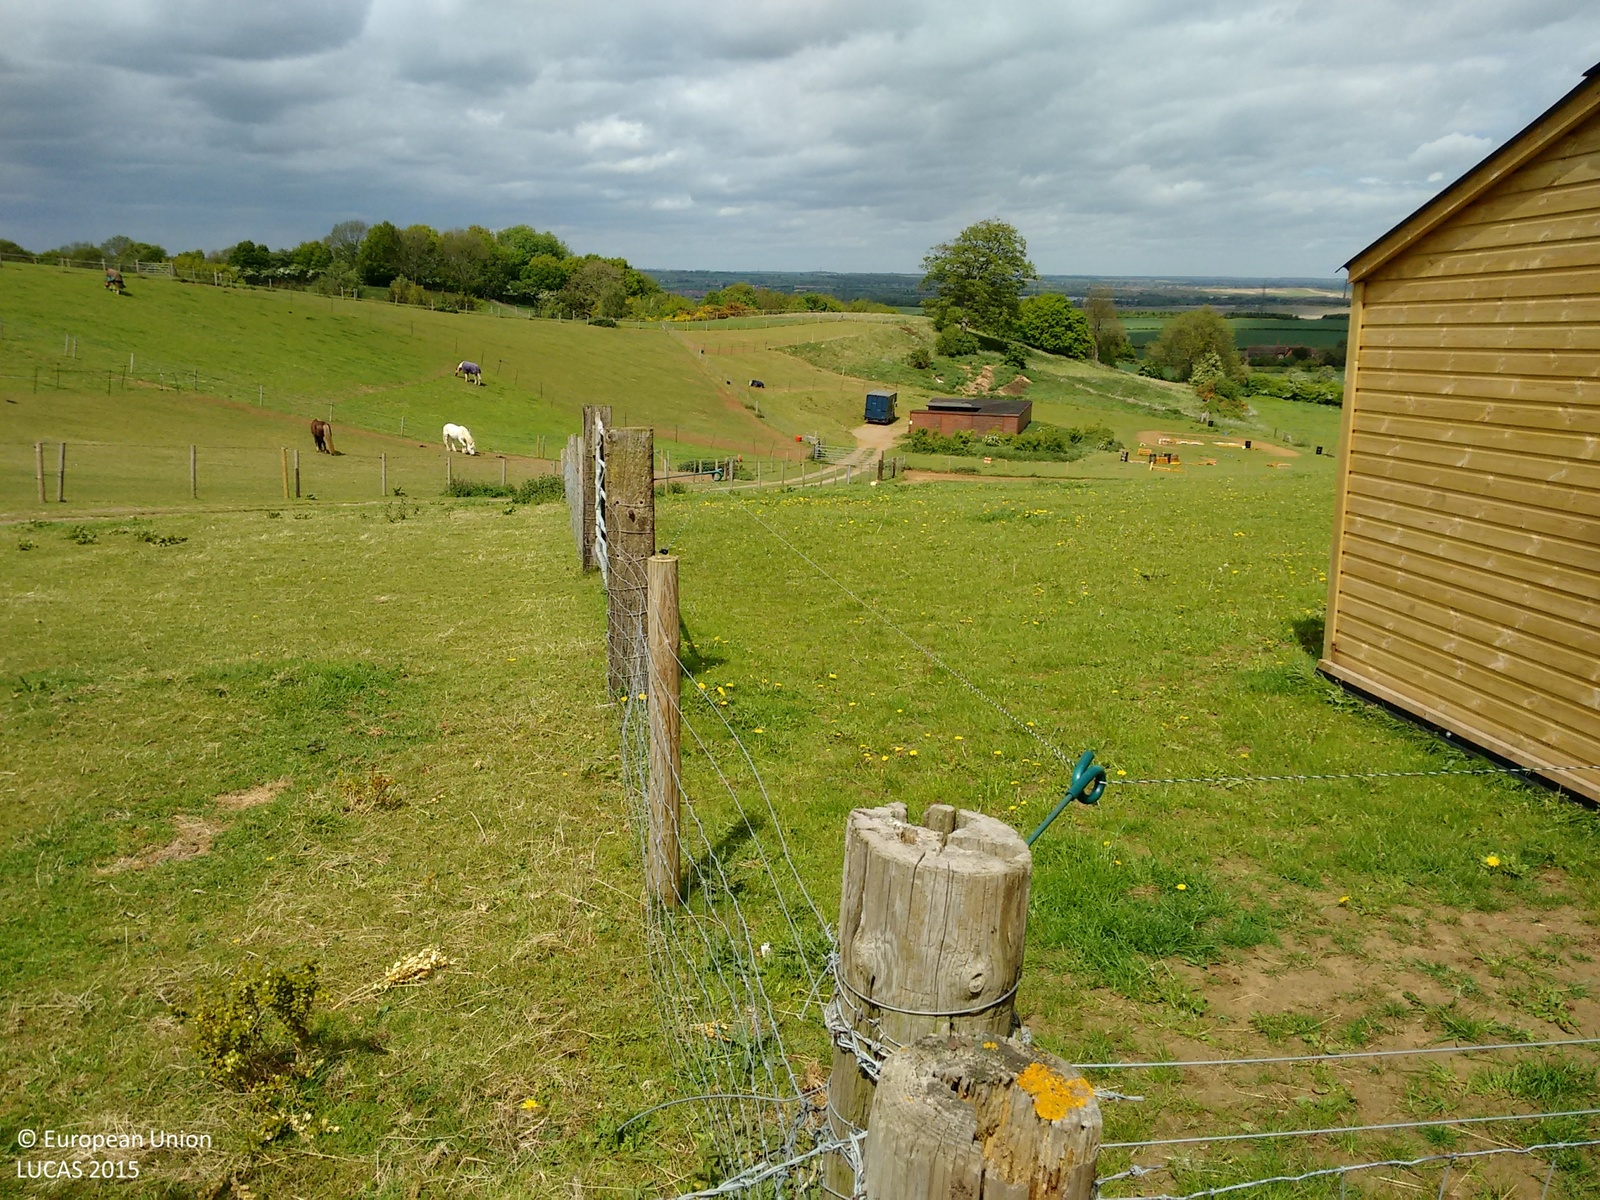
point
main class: Grassland
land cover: Grassland without tree/shrub cover
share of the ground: > 75 %
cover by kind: herbaceous plants 100 %
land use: Amenities, museums, leisure
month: May
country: GB
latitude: 52.0356
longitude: -0.5197
